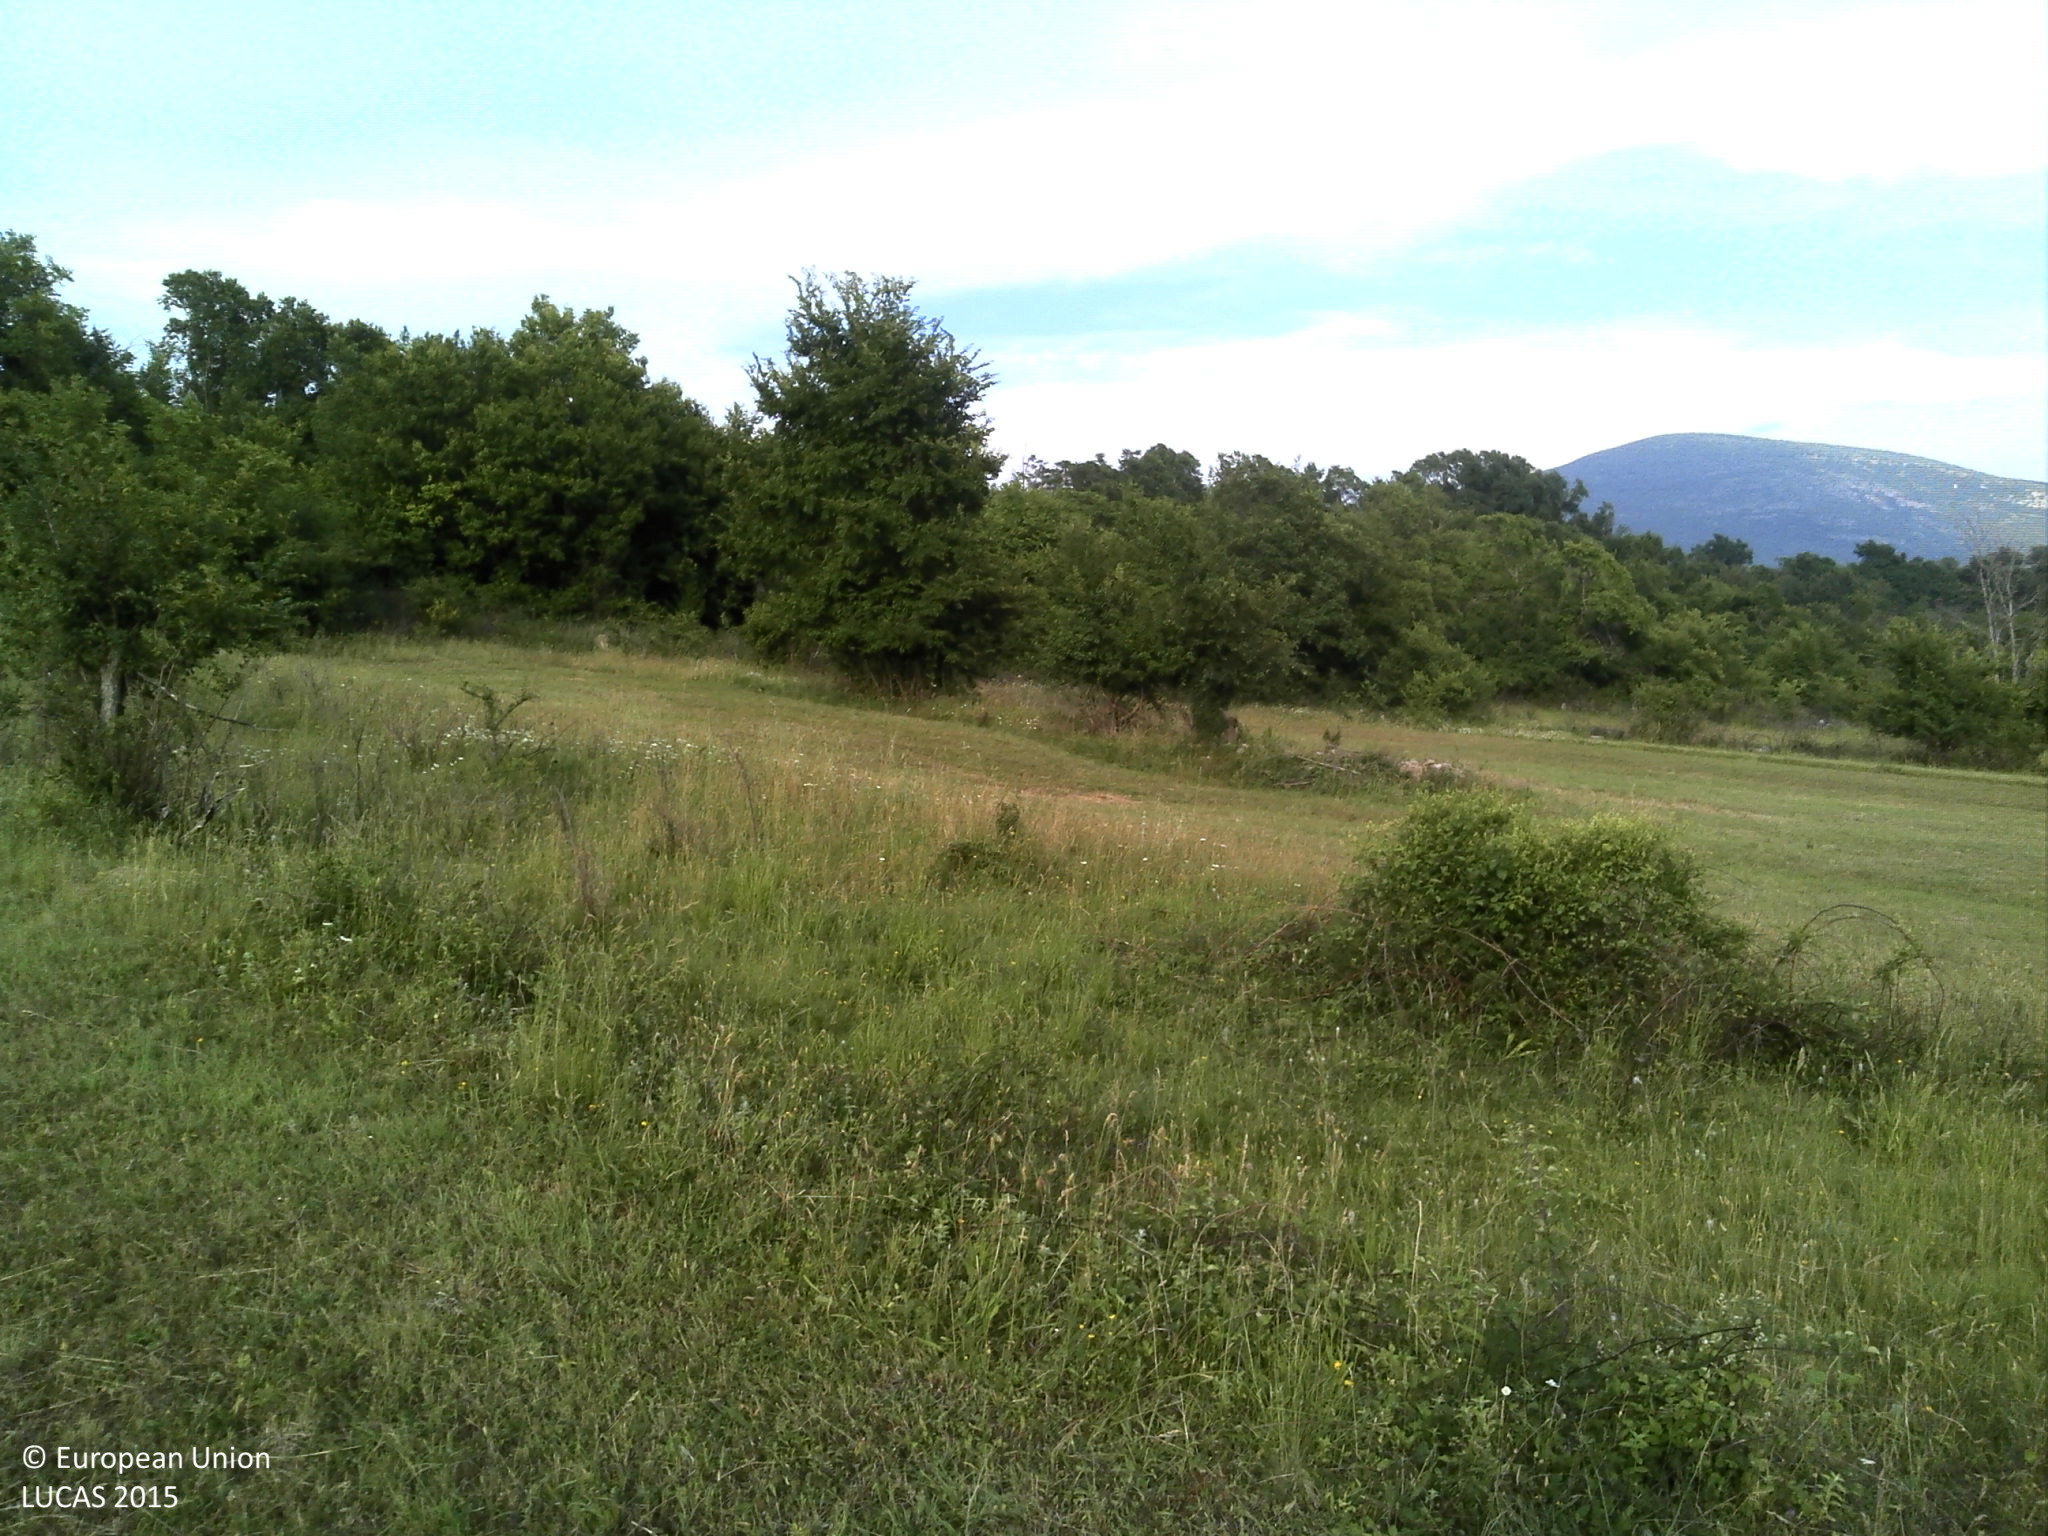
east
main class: Grassland
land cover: Grassland with sparse tree/shrub cover
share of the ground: > 75 %
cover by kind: herbaceous plants 90 %, broadleaved forest trees 5 %, shrubs 5 %
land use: Agriculture (excluding fallow land and kitchen gardens)
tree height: < 5 m
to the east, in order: Grassland with sparse tree/shrub cover; Dry stone walls; Grassland with sparse tree/shrub cover; Shrubland with sparse tree cover; Grassland with sparse tree/shrub cover; Broadleaved woodland; Artificial constructions in urban areas; Broadleaved woodland; Artificial constructions in urban areas; Grassland with sparse tree/shrub cover; Tracks; Grassland with sparse tree/shrub cover
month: June
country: HR
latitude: 43.8948
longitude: 16.4783
